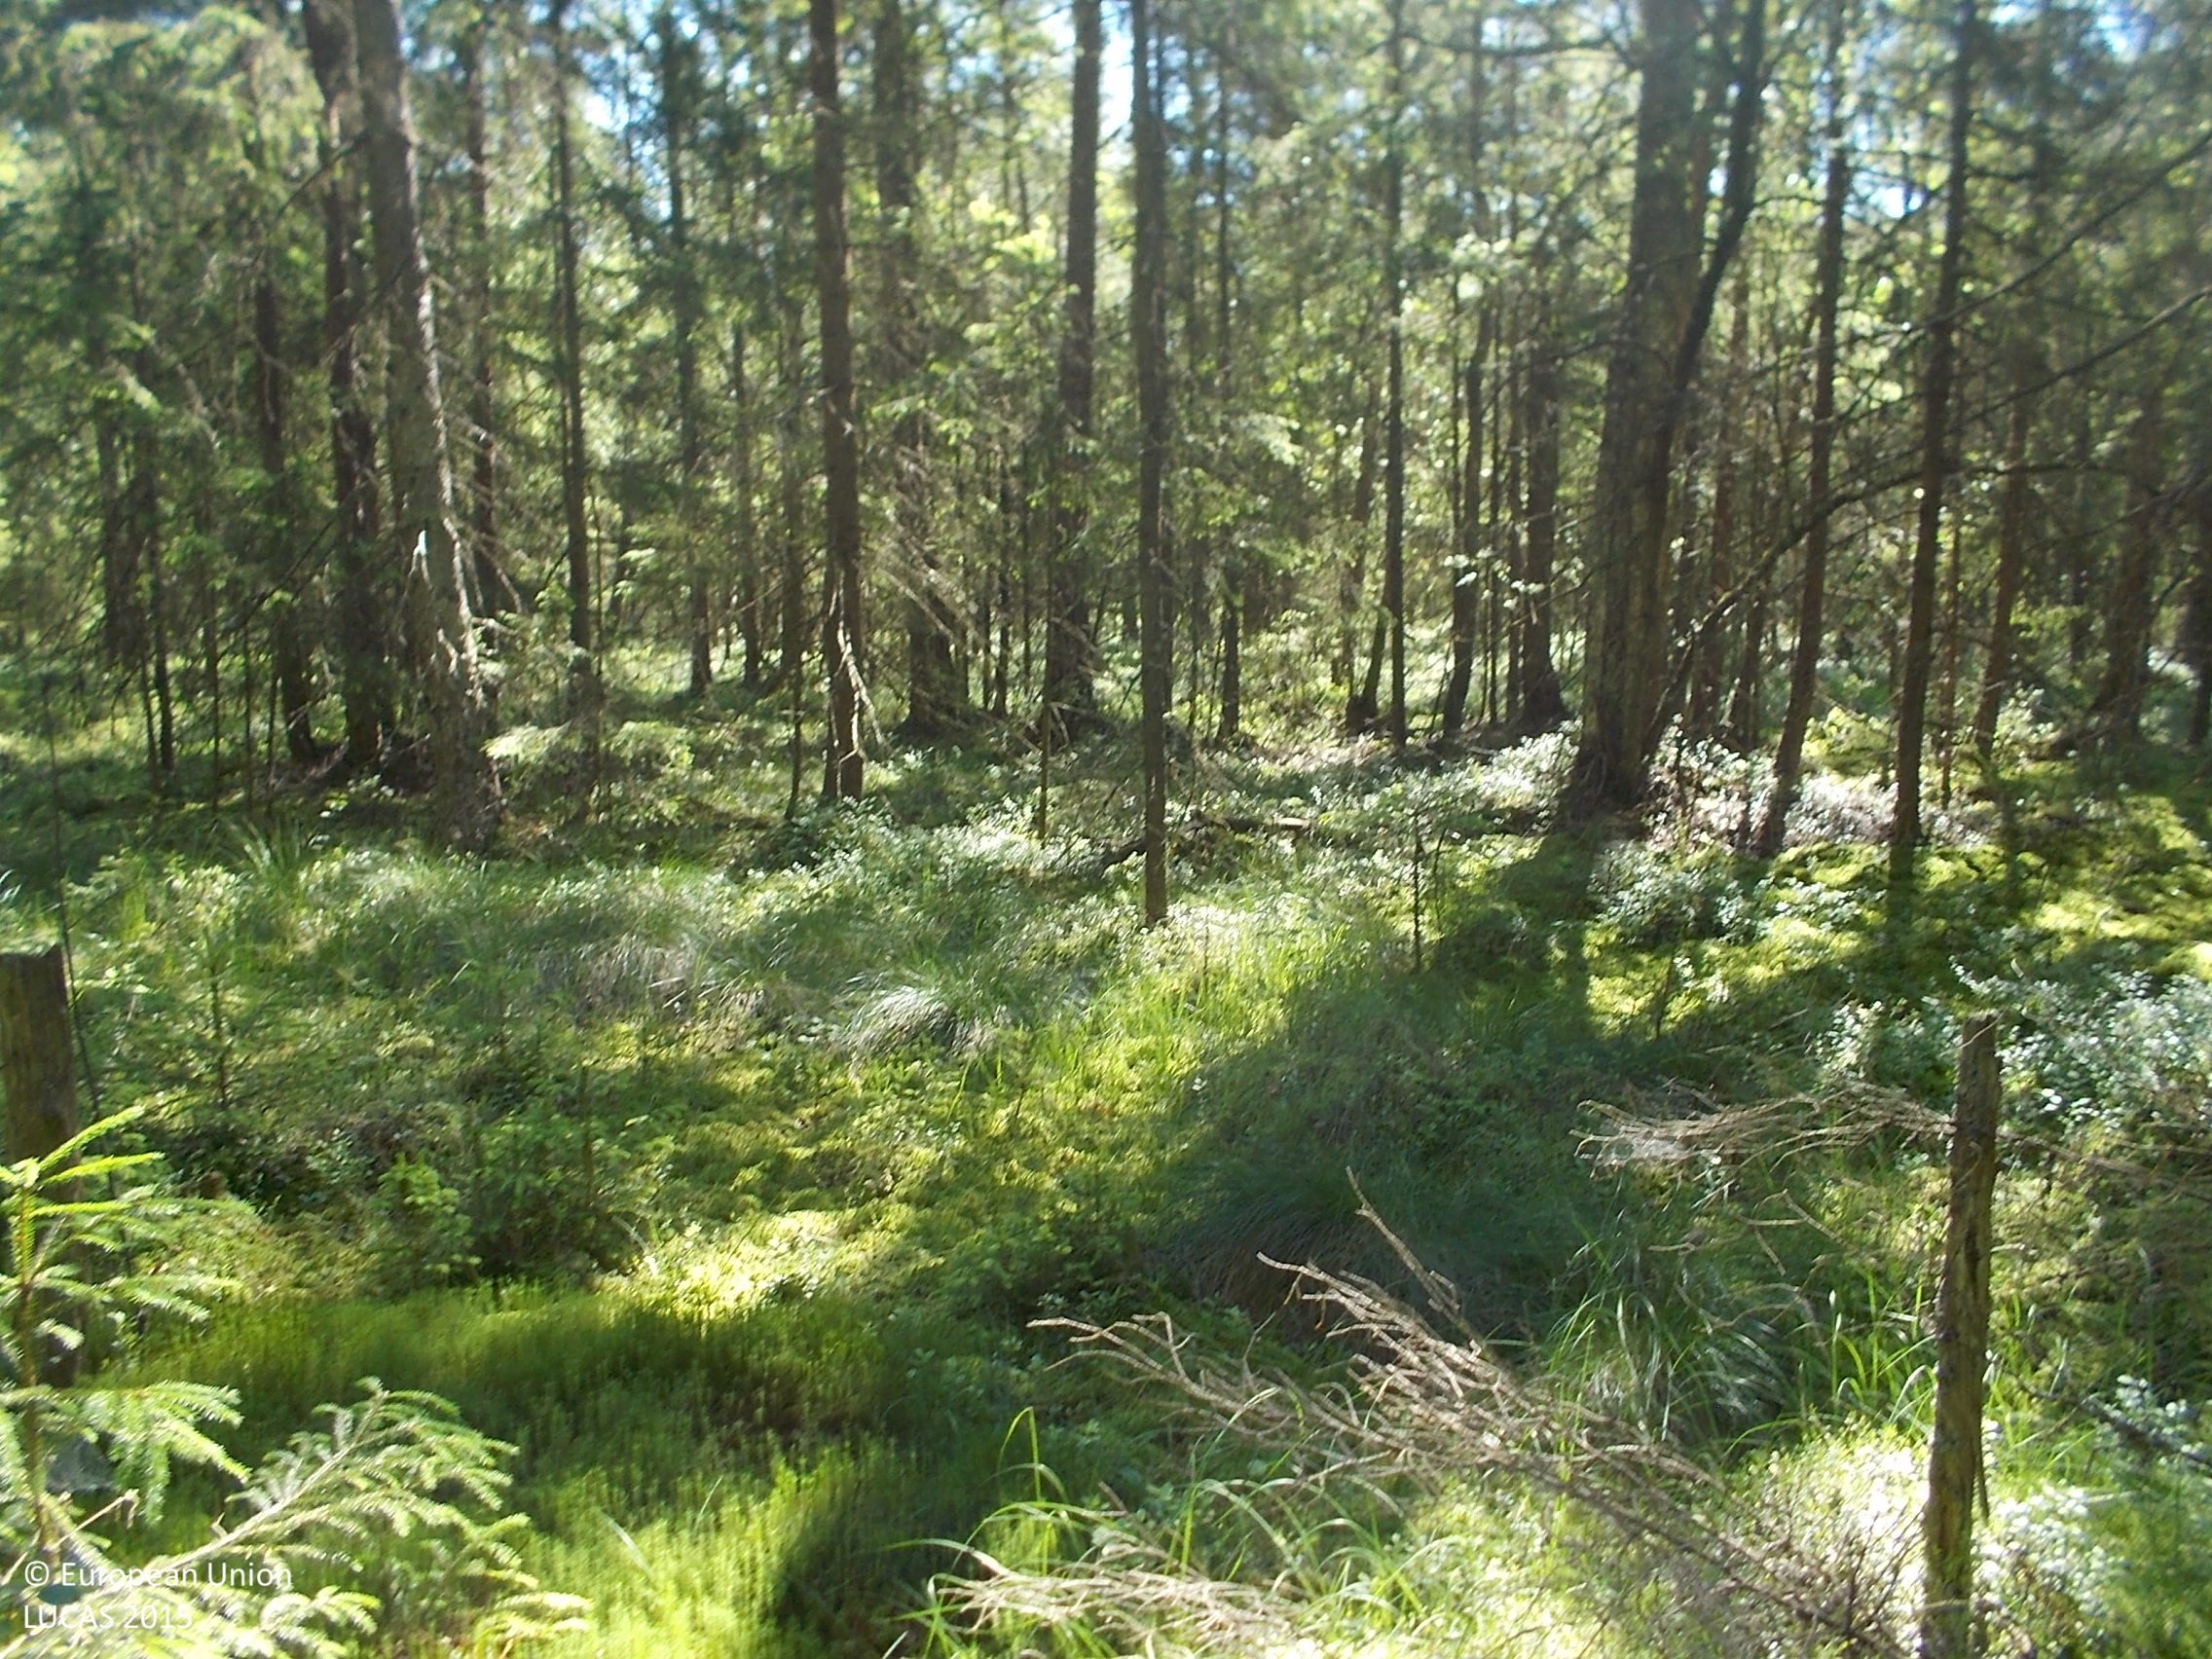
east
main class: Woodland
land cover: Spruce dominated coniferous woodland
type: mire and swamp forests
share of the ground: 50 - 75 %
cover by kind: coniferous forest trees 70 %, lichens and mosses 20 %, shrubs 5 %, herbaceous plants 5 %
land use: Forestry
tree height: > 5 m
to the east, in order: Spruce dominated coniferous woodland; Spruce dominated mixed woodland; Pine dominated coniferous woodland; Ditches and canals; Spruce dominated coniferous woodland; Groves; Tracks; Ditches and canals; Groves; Spruce dominated coniferous woodland; Spruce dominated mixed woodland; Spruce dominated coniferous woodland
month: July
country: SE
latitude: 57.3167
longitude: 13.2337
